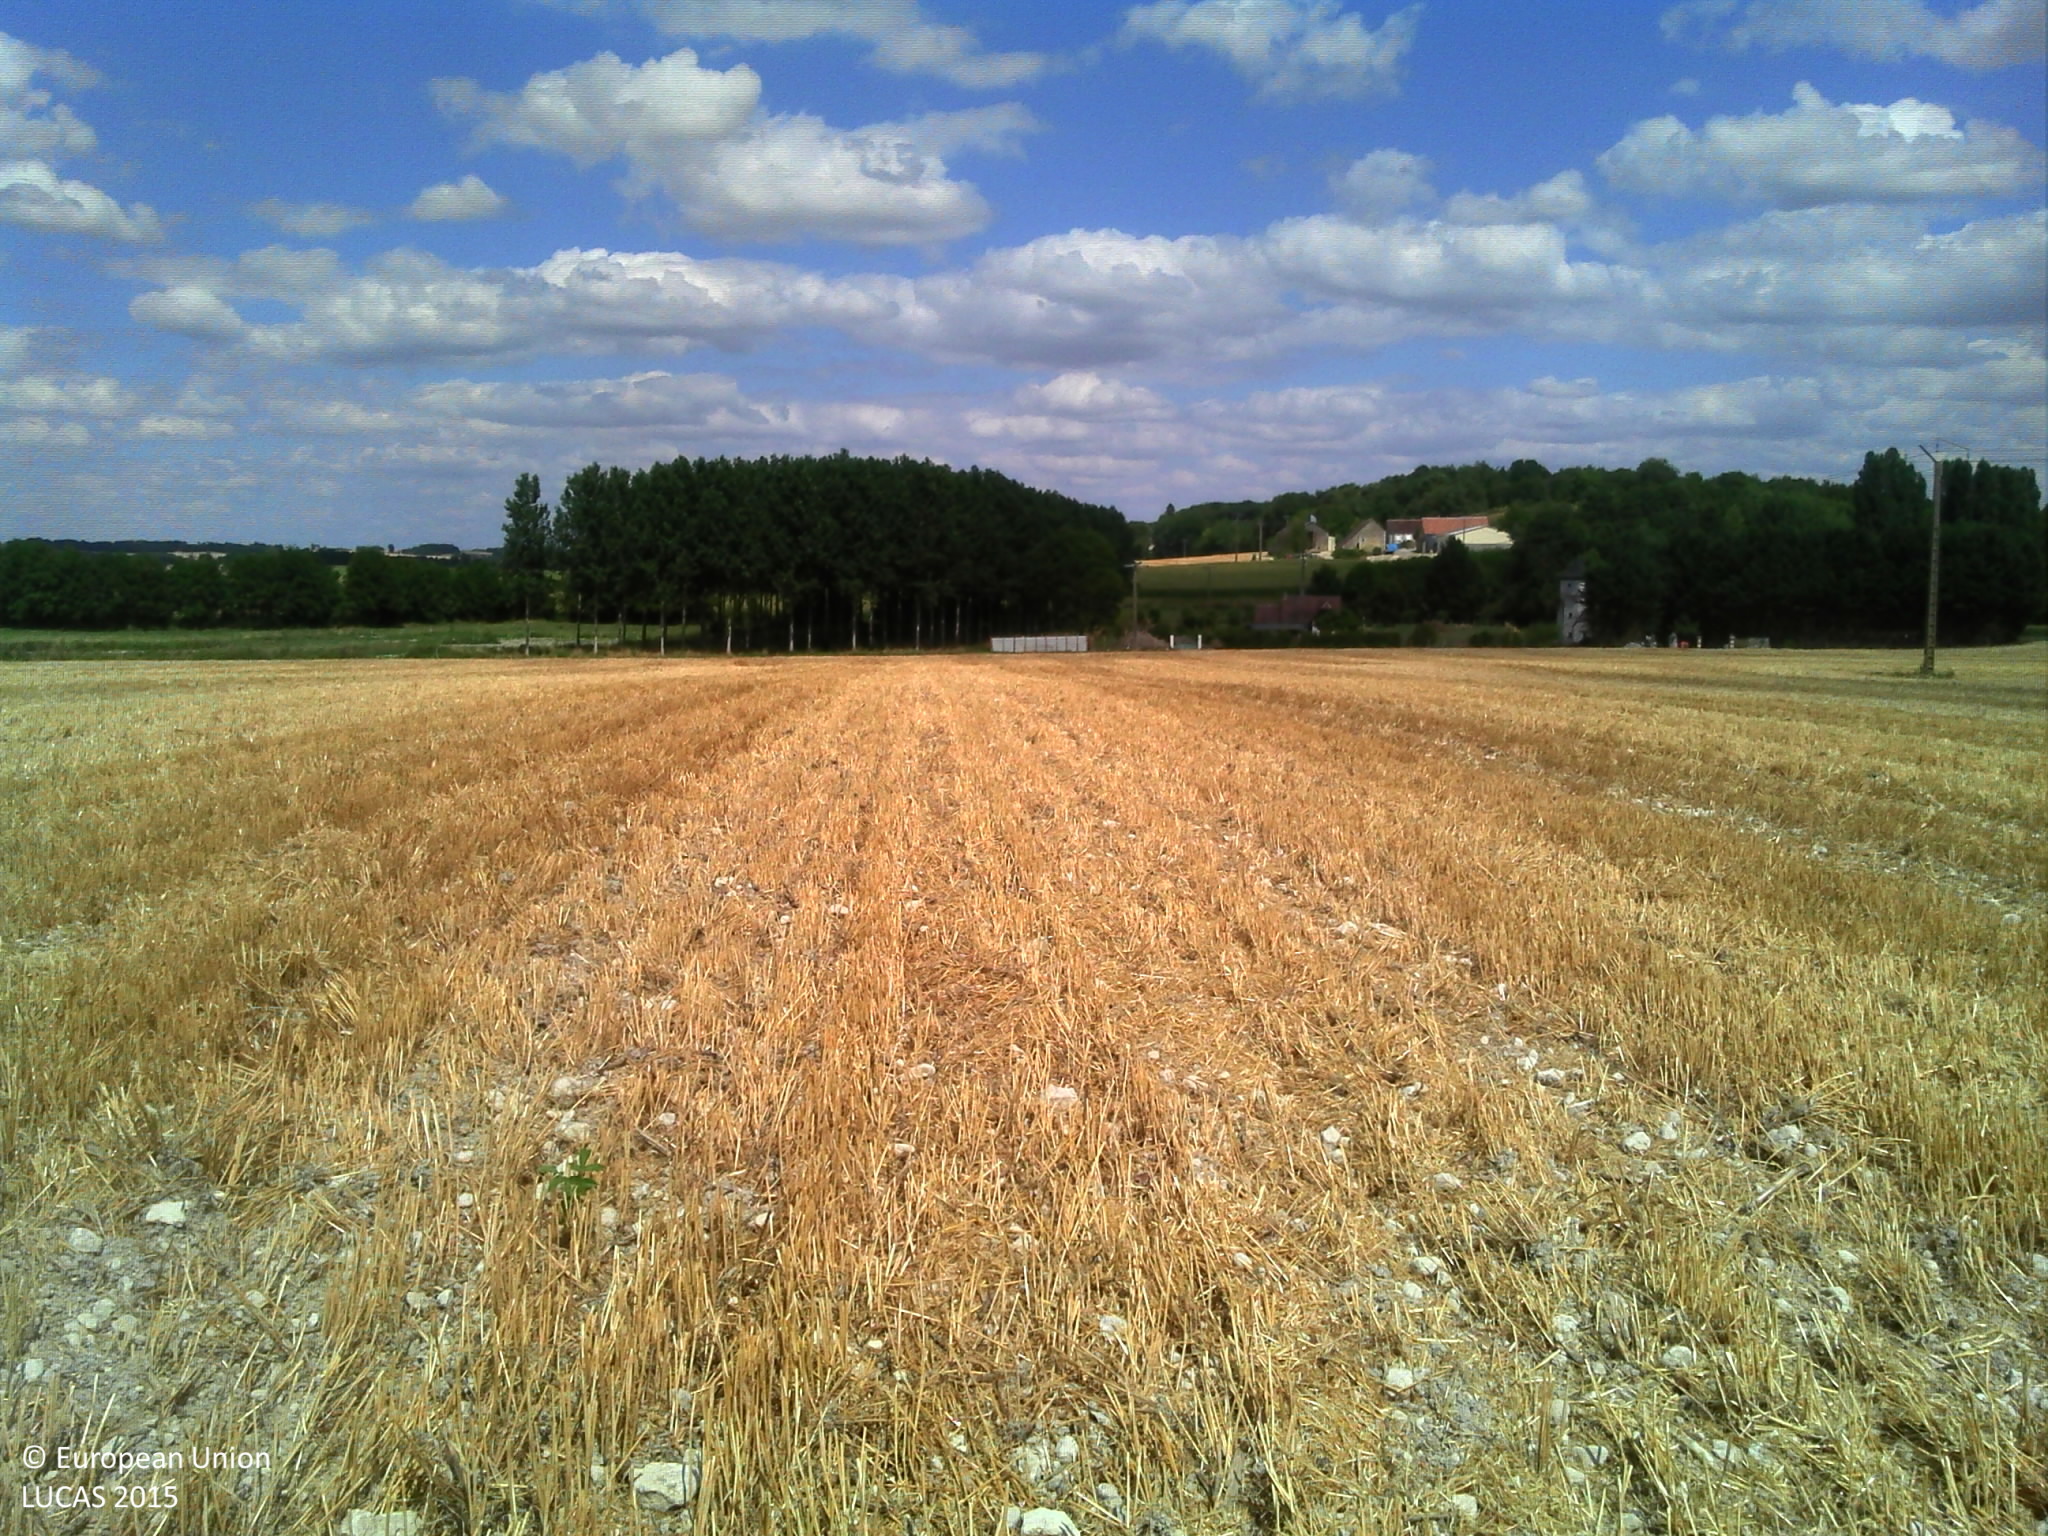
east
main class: Cropland
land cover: Common wheat
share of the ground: > 75 %
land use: Agriculture (excluding fallow land and kitchen gardens)
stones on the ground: > 50 %
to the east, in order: Common wheat; Electric lines; Common wheat
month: July
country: FR
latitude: 47.0464
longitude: 0.8616
